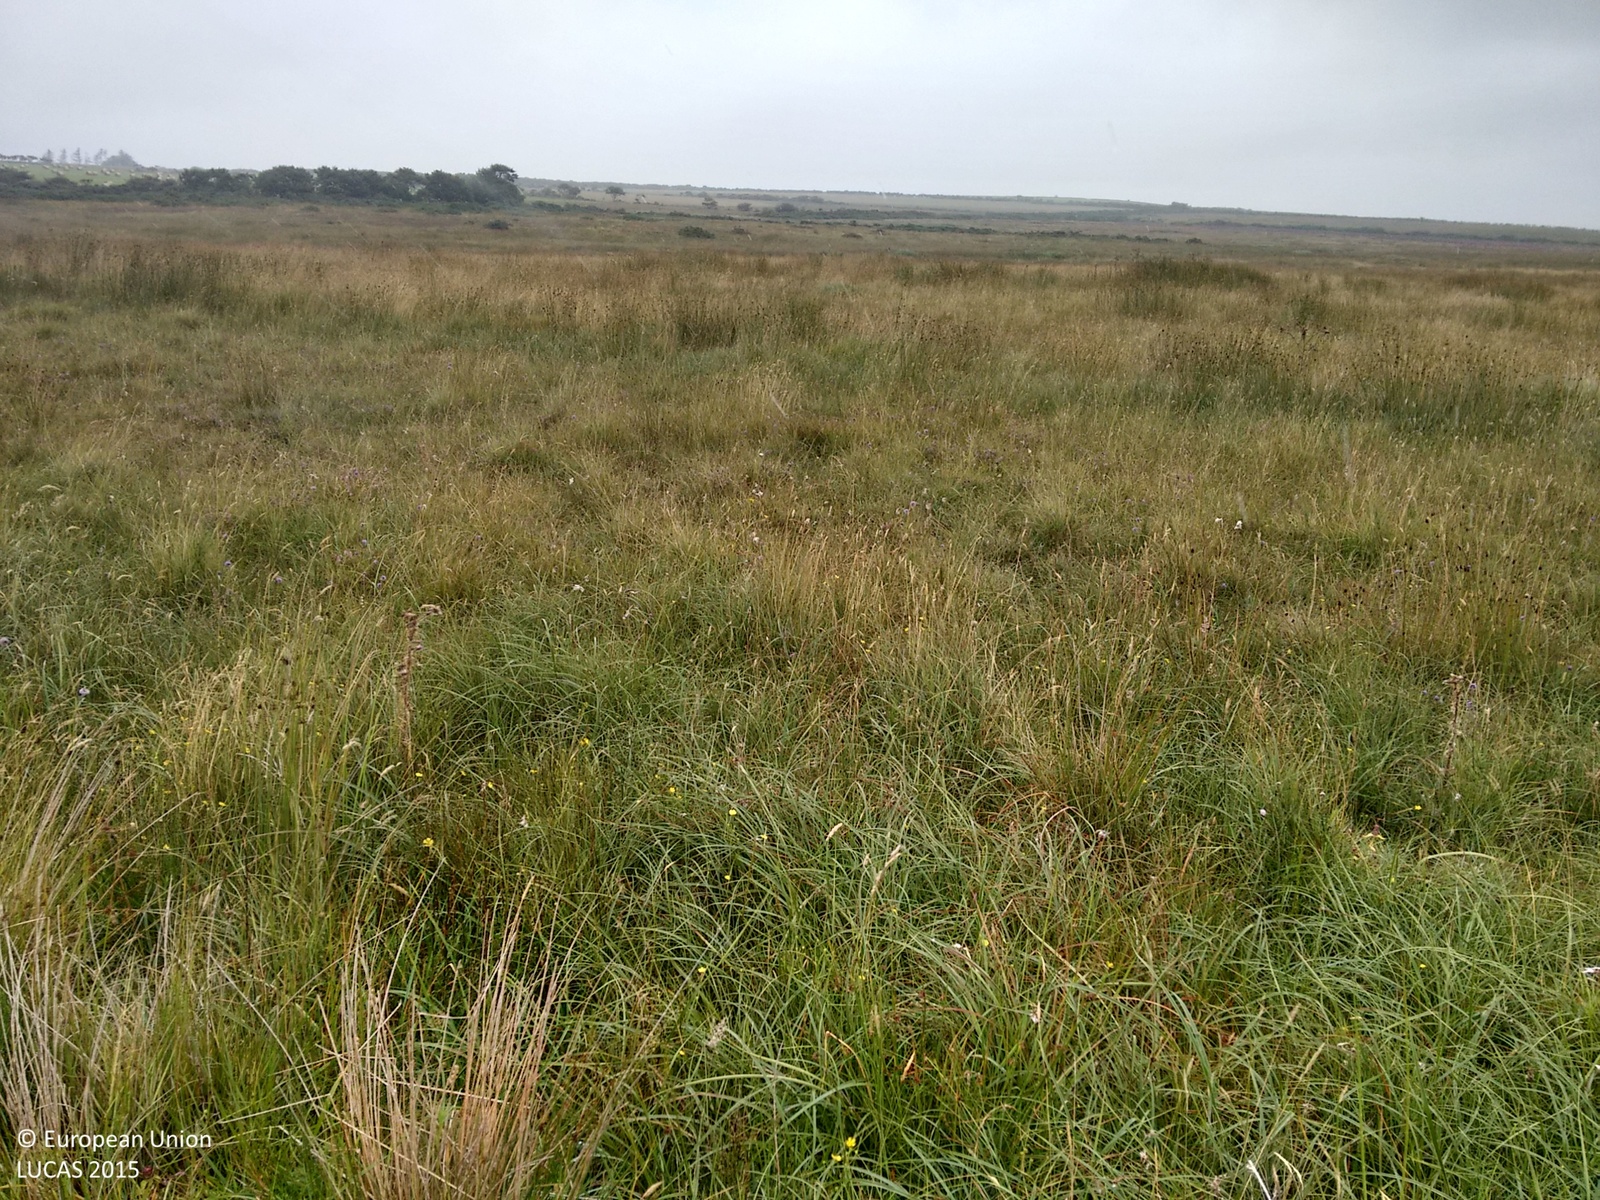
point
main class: Grassland
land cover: Grassland without tree/shrub cover
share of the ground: > 75 %
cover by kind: herbaceous plants 95 %, shrubs 5 %
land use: Agriculture (excluding fallow land and kitchen gardens)
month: August
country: GB
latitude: 58.5617
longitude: -3.2788
